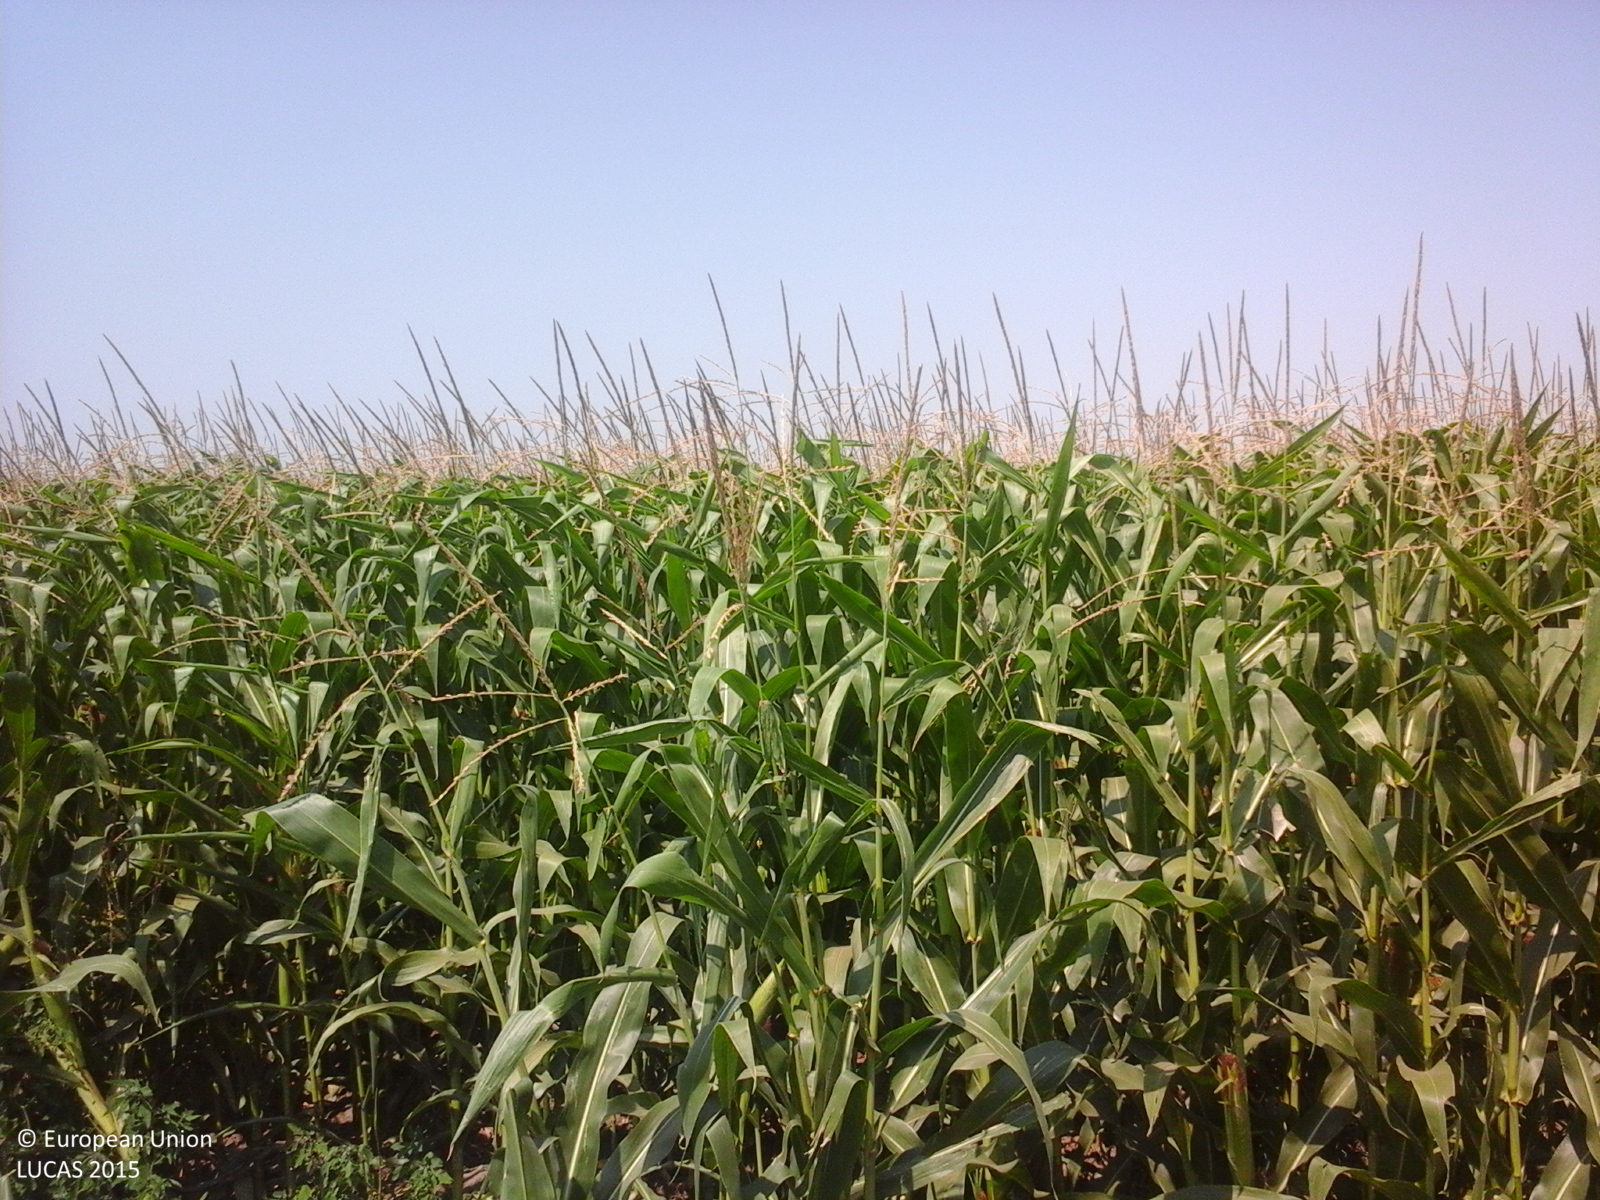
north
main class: Cropland
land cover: Maize
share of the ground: > 75 %
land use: Agriculture (excluding fallow land and kitchen gardens)
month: July
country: RO
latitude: 44.7235
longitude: 27.0895
